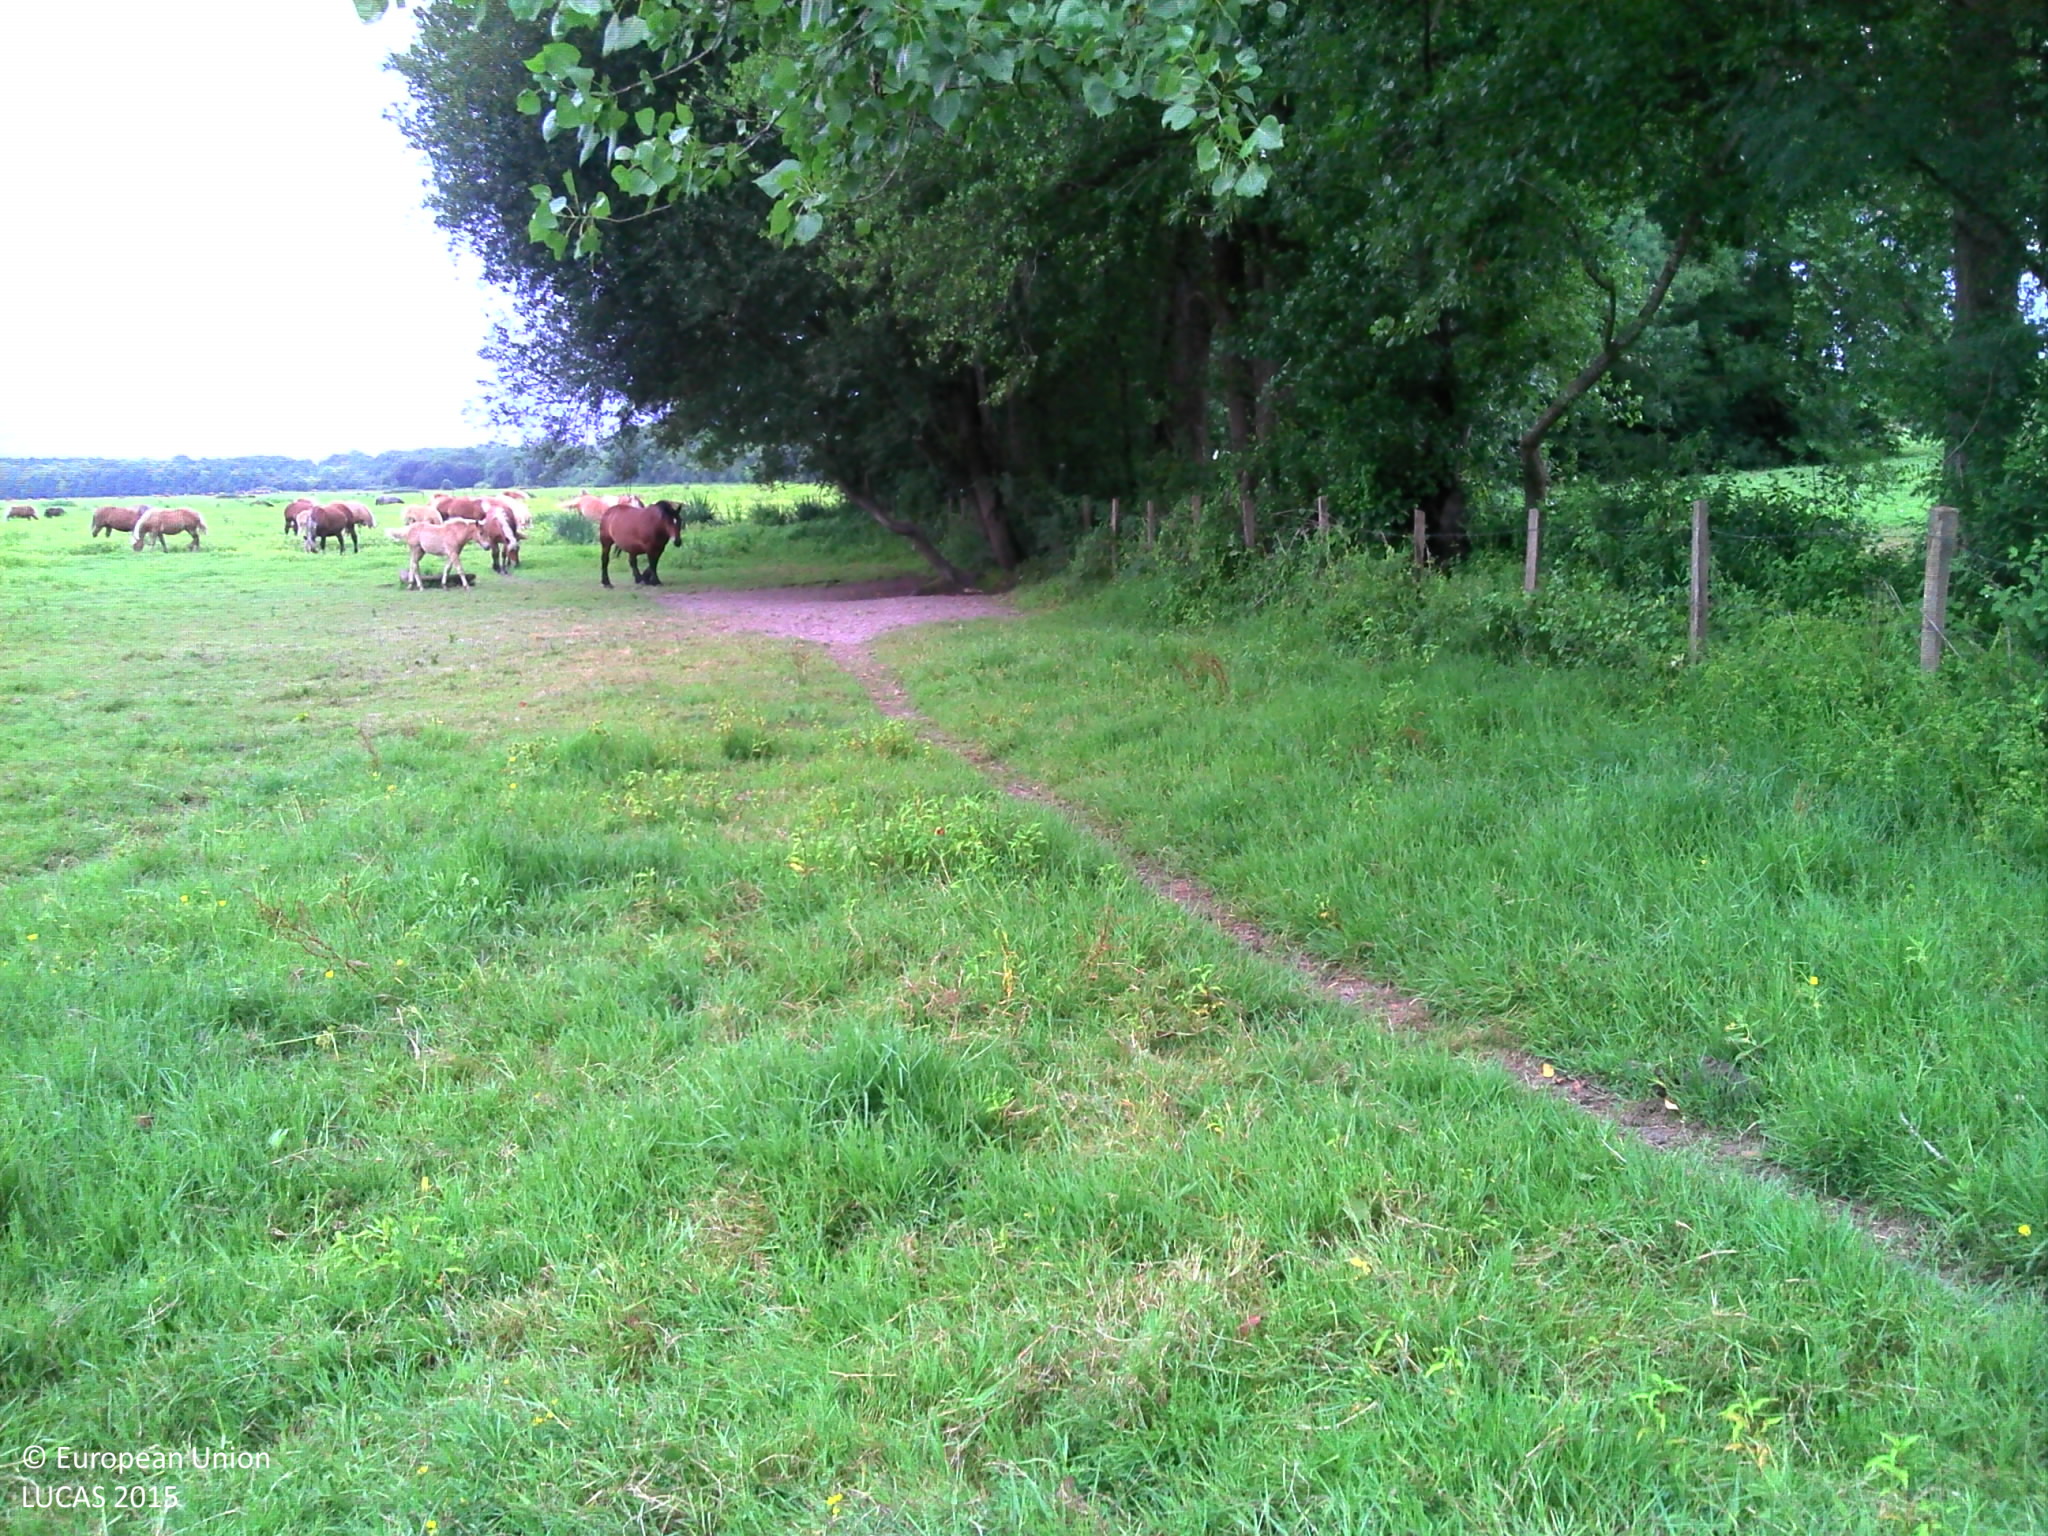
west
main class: Grassland
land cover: Grassland without tree/shrub cover
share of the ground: > 75 %
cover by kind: herbaceous plants 95 %, unconsolidated bare surface 5 %
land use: Agriculture (excluding fallow land and kitchen gardens)
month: July
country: FR
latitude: 43.6731
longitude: -1.1668
